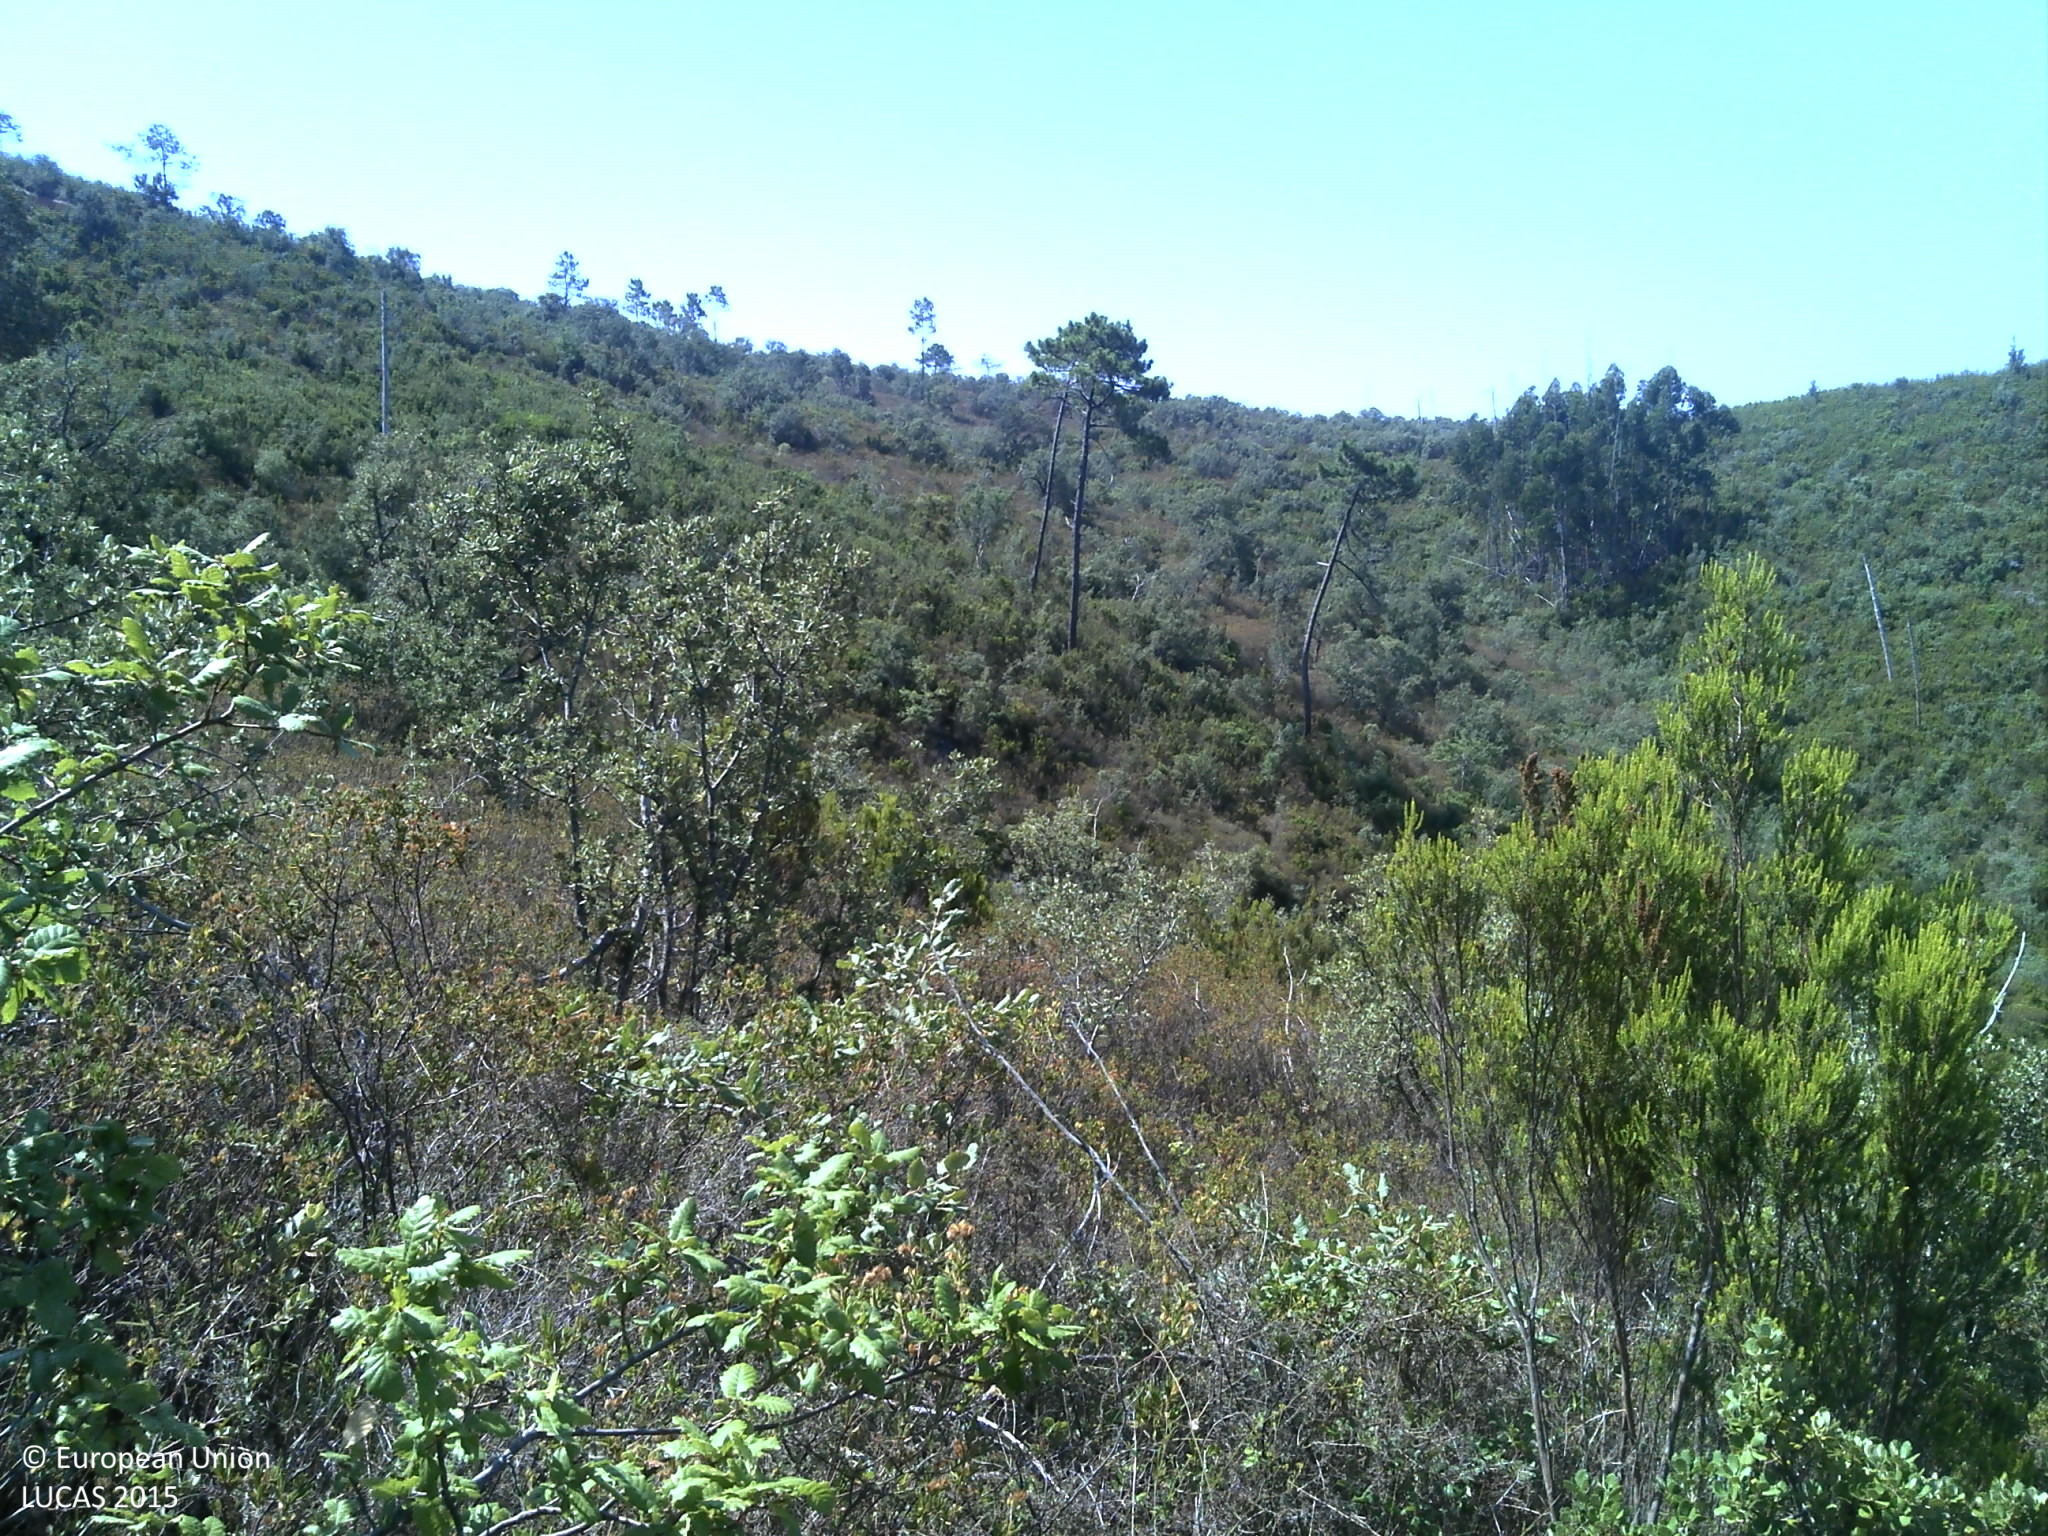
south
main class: Woodland
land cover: Broadleaved woodland
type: broadleaved evergreen forest
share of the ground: 25 - 50 %
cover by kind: shrubs 50 %, broadleaved forest trees 30 %, unconsolidated bare surface 15 %, consolidated bare surface 5 %
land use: Abandoned areas
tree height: < 5 m
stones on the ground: > 50 %
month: June
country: PT
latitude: 39.7477
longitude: -8.4090
